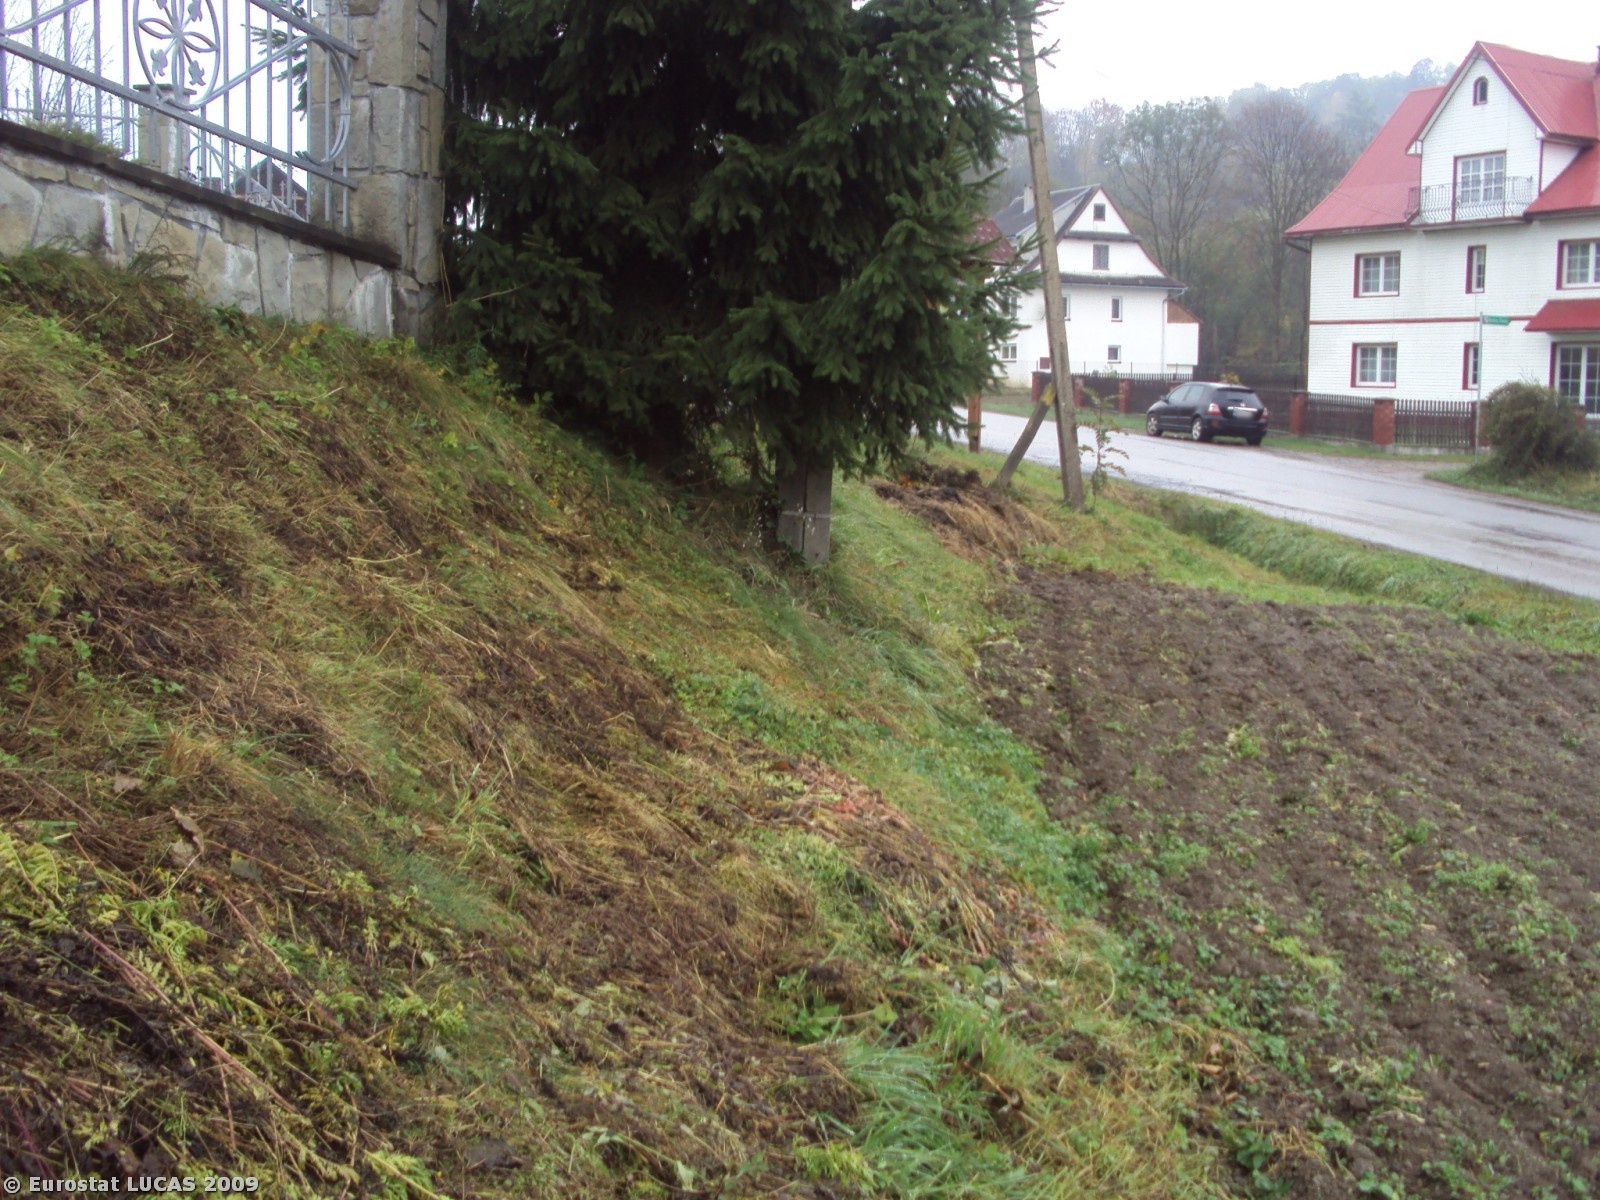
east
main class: Grassland
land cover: Grassland without tree/shrub cover
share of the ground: > 75 %
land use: Agriculture (excluding fallow land and kitchen gardens)
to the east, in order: Grassland without tree/shrub cover; Fences; Artificial constructions in urban areas; Fences; Grassland without tree/shrub cover; Single bushes/trees; Grassland without tree/shrub cover; Paved roads, cycling and walking lanes; Grassland without tree/shrub cover; Paved roads, cycling and walking lanes; Grassland without tree/shrub cover; Tracks; Grassland without tree/shrub cover; Broadleaved woodland
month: September
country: PL
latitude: 49.6770
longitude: 20.1358
